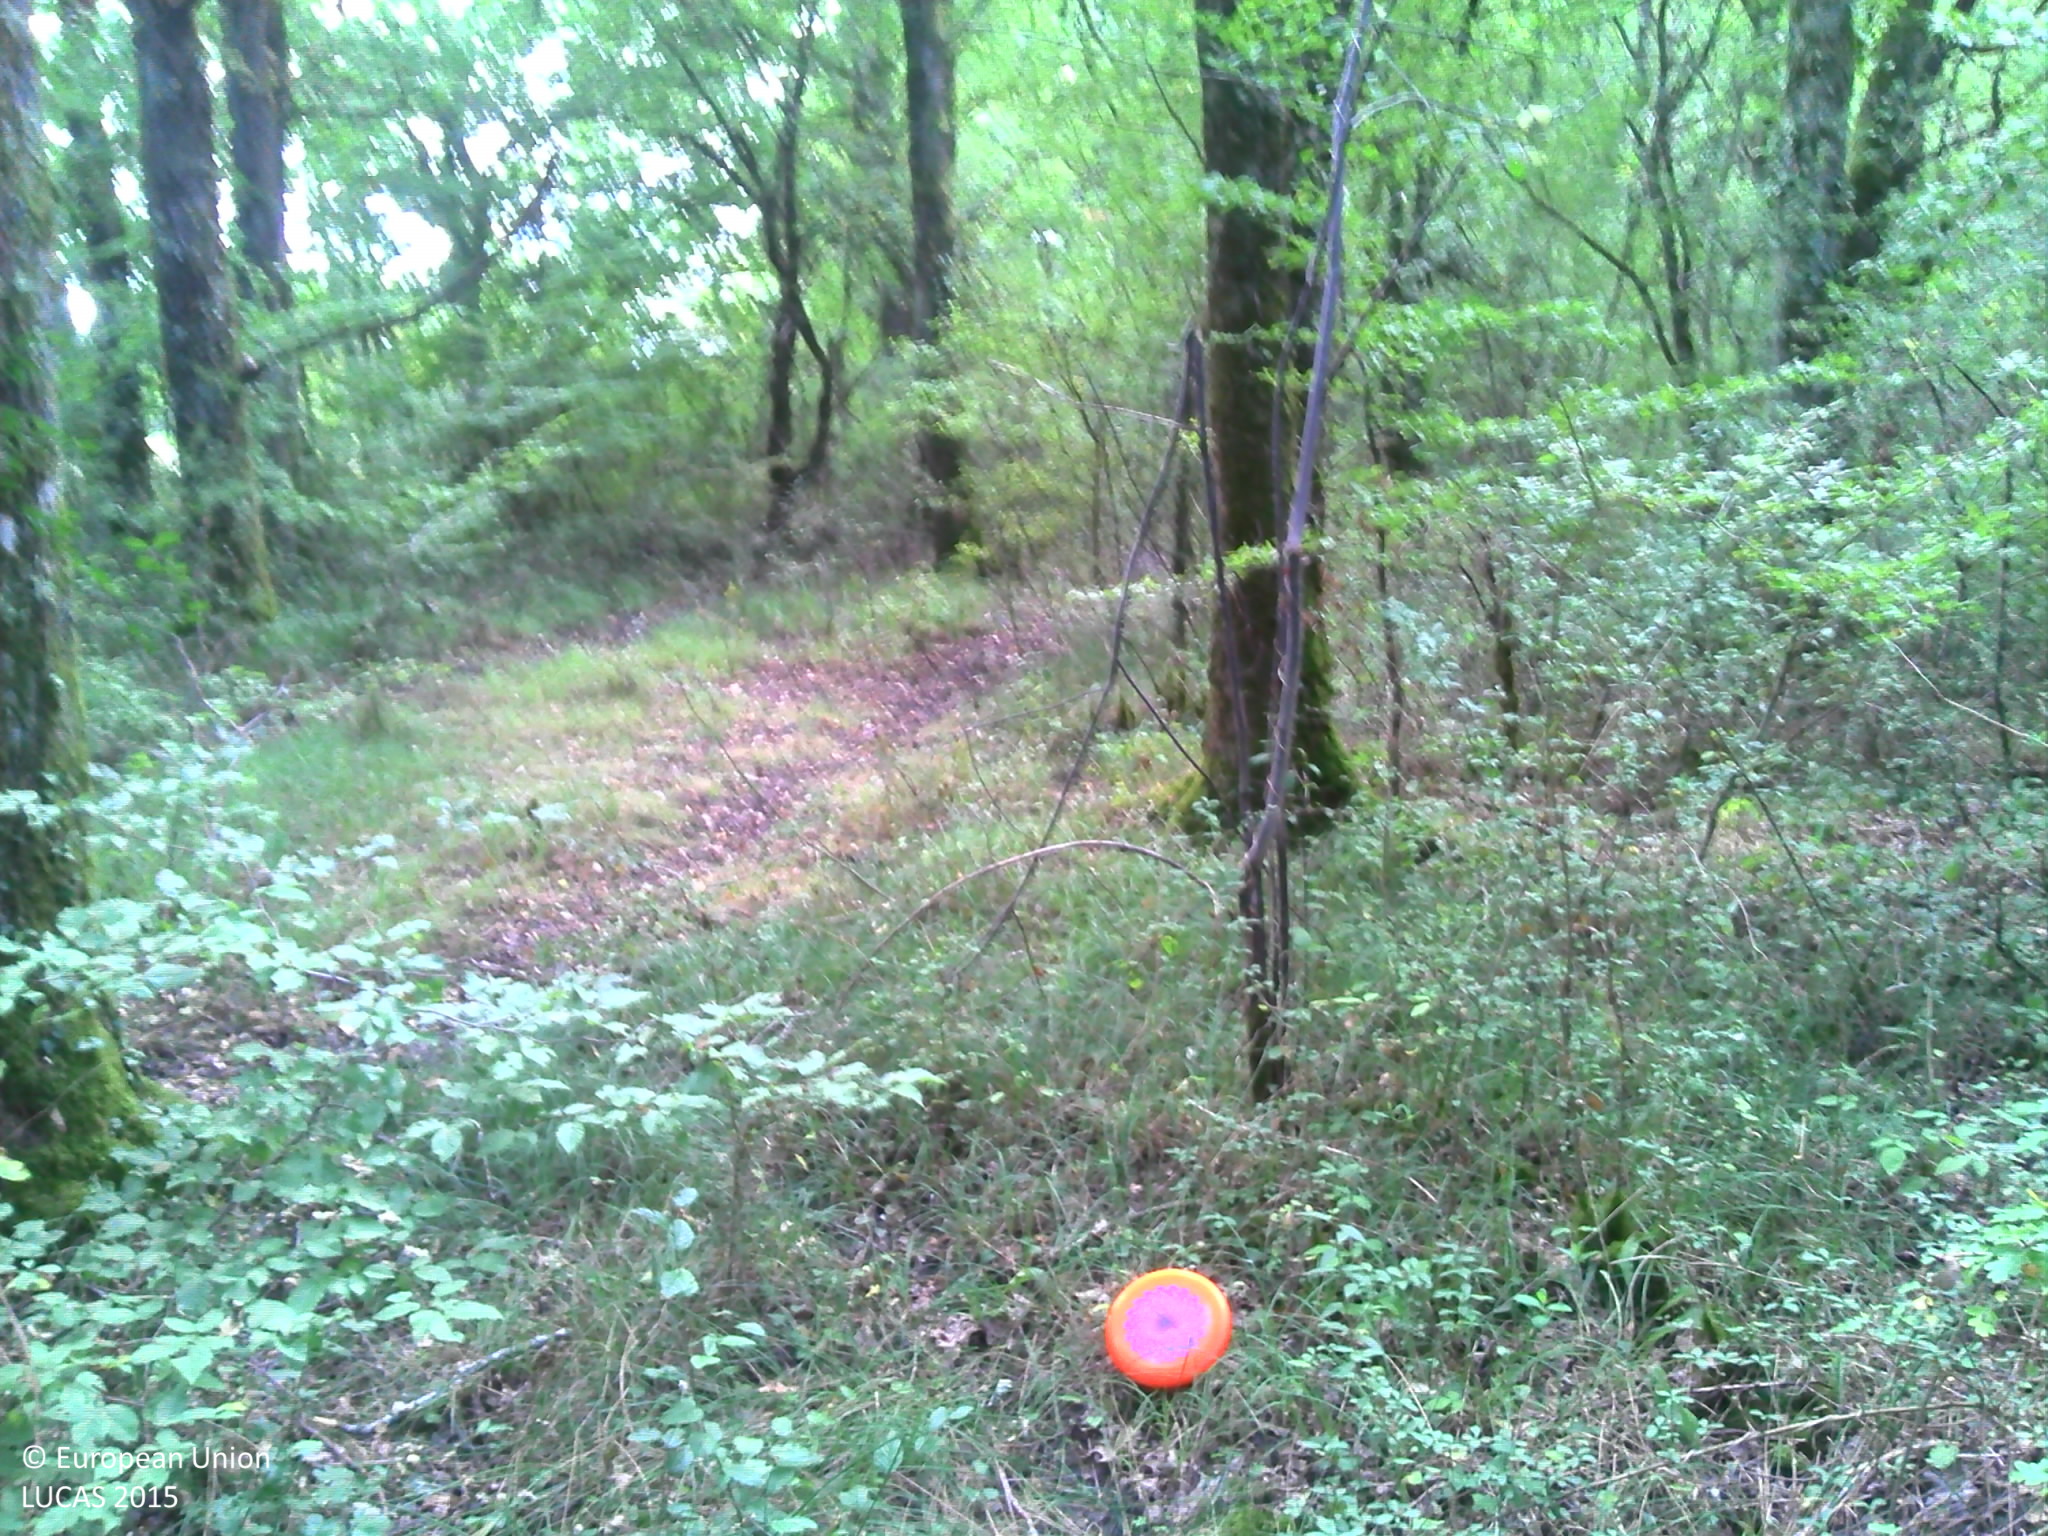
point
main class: Woodland
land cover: Broadleaved woodland
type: mesophytic deciduous forest
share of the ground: > 75 %
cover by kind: broadleaved forest trees 85 %, shrubs 10 %, herbaceous plants 5 %
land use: Forestry
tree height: > 5 m
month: July
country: FR
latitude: 46.7520
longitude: 1.4664
